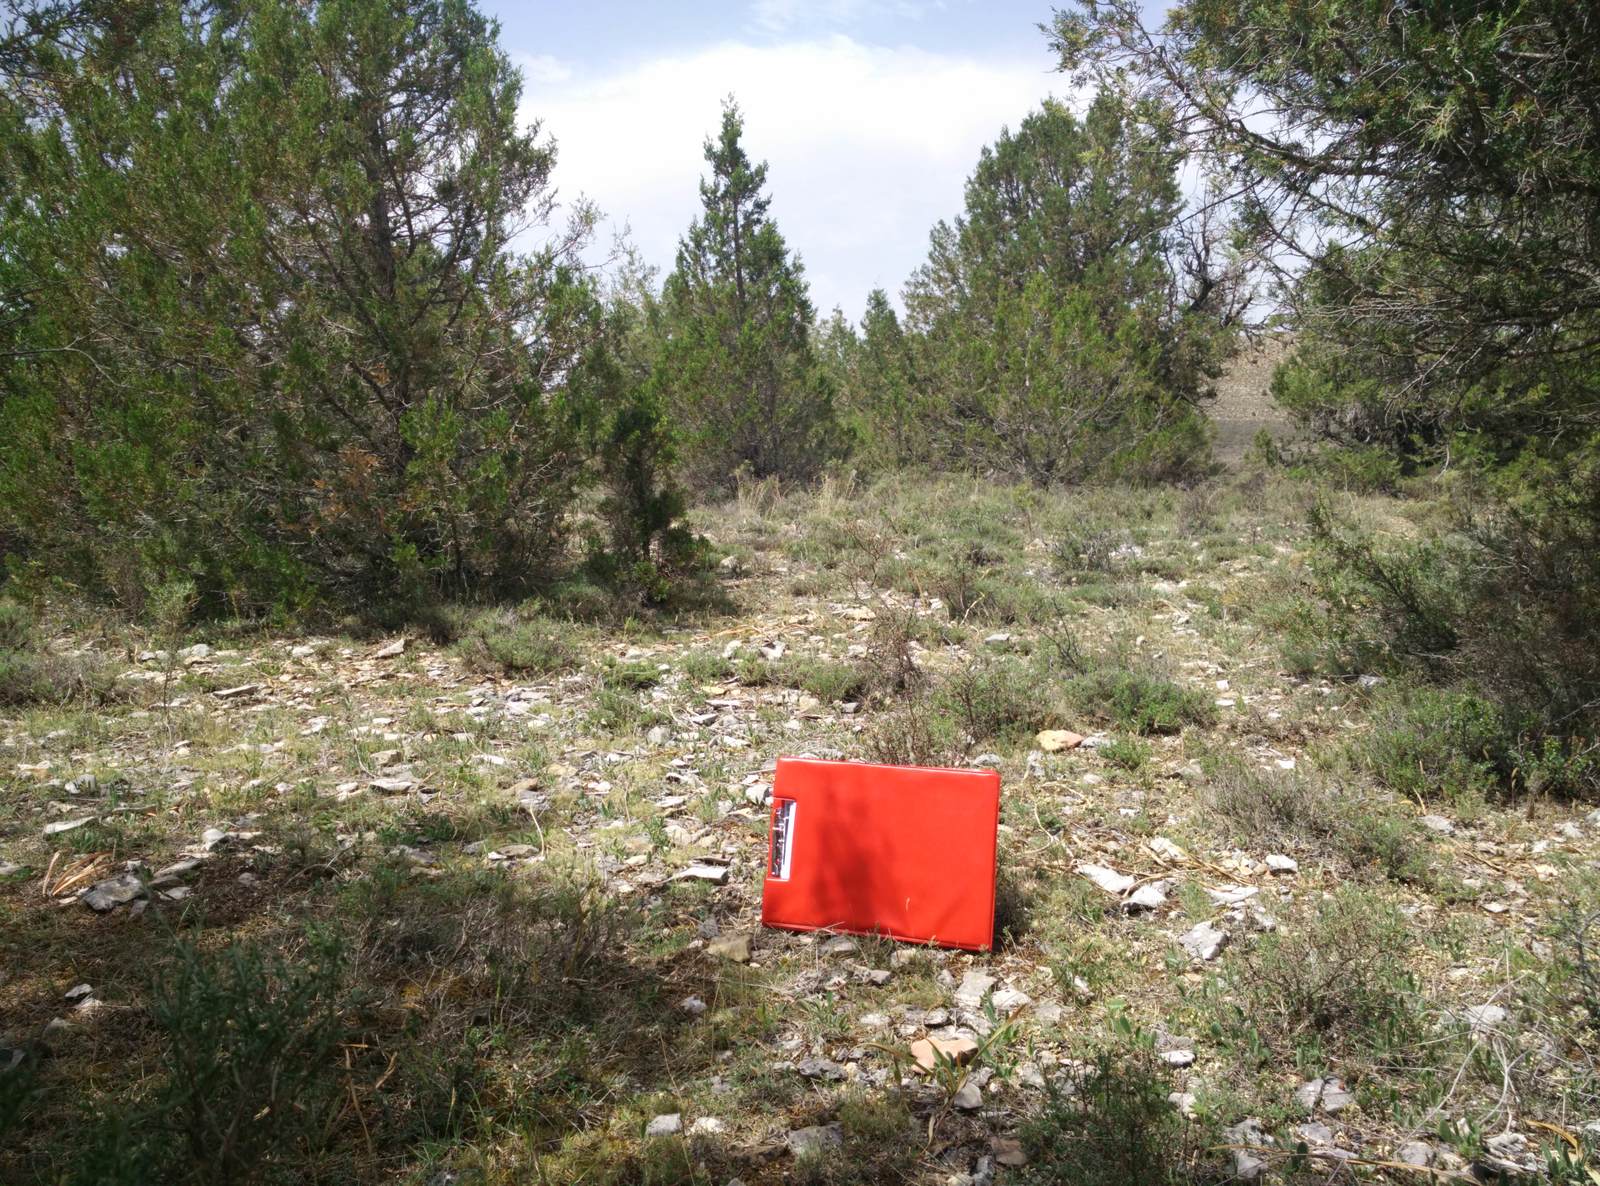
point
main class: Woodland
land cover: Other coniferous woodland
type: coniferous forest of the mediterranean region
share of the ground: 50 - 75 %
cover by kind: coniferous forest trees 65 %, unconsolidated bare surface 20 %, shrubs 15 %
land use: Semi-natural and natural areas not in use
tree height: > 5 m
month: July
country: ES
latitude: 40.9989
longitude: -2.0684
